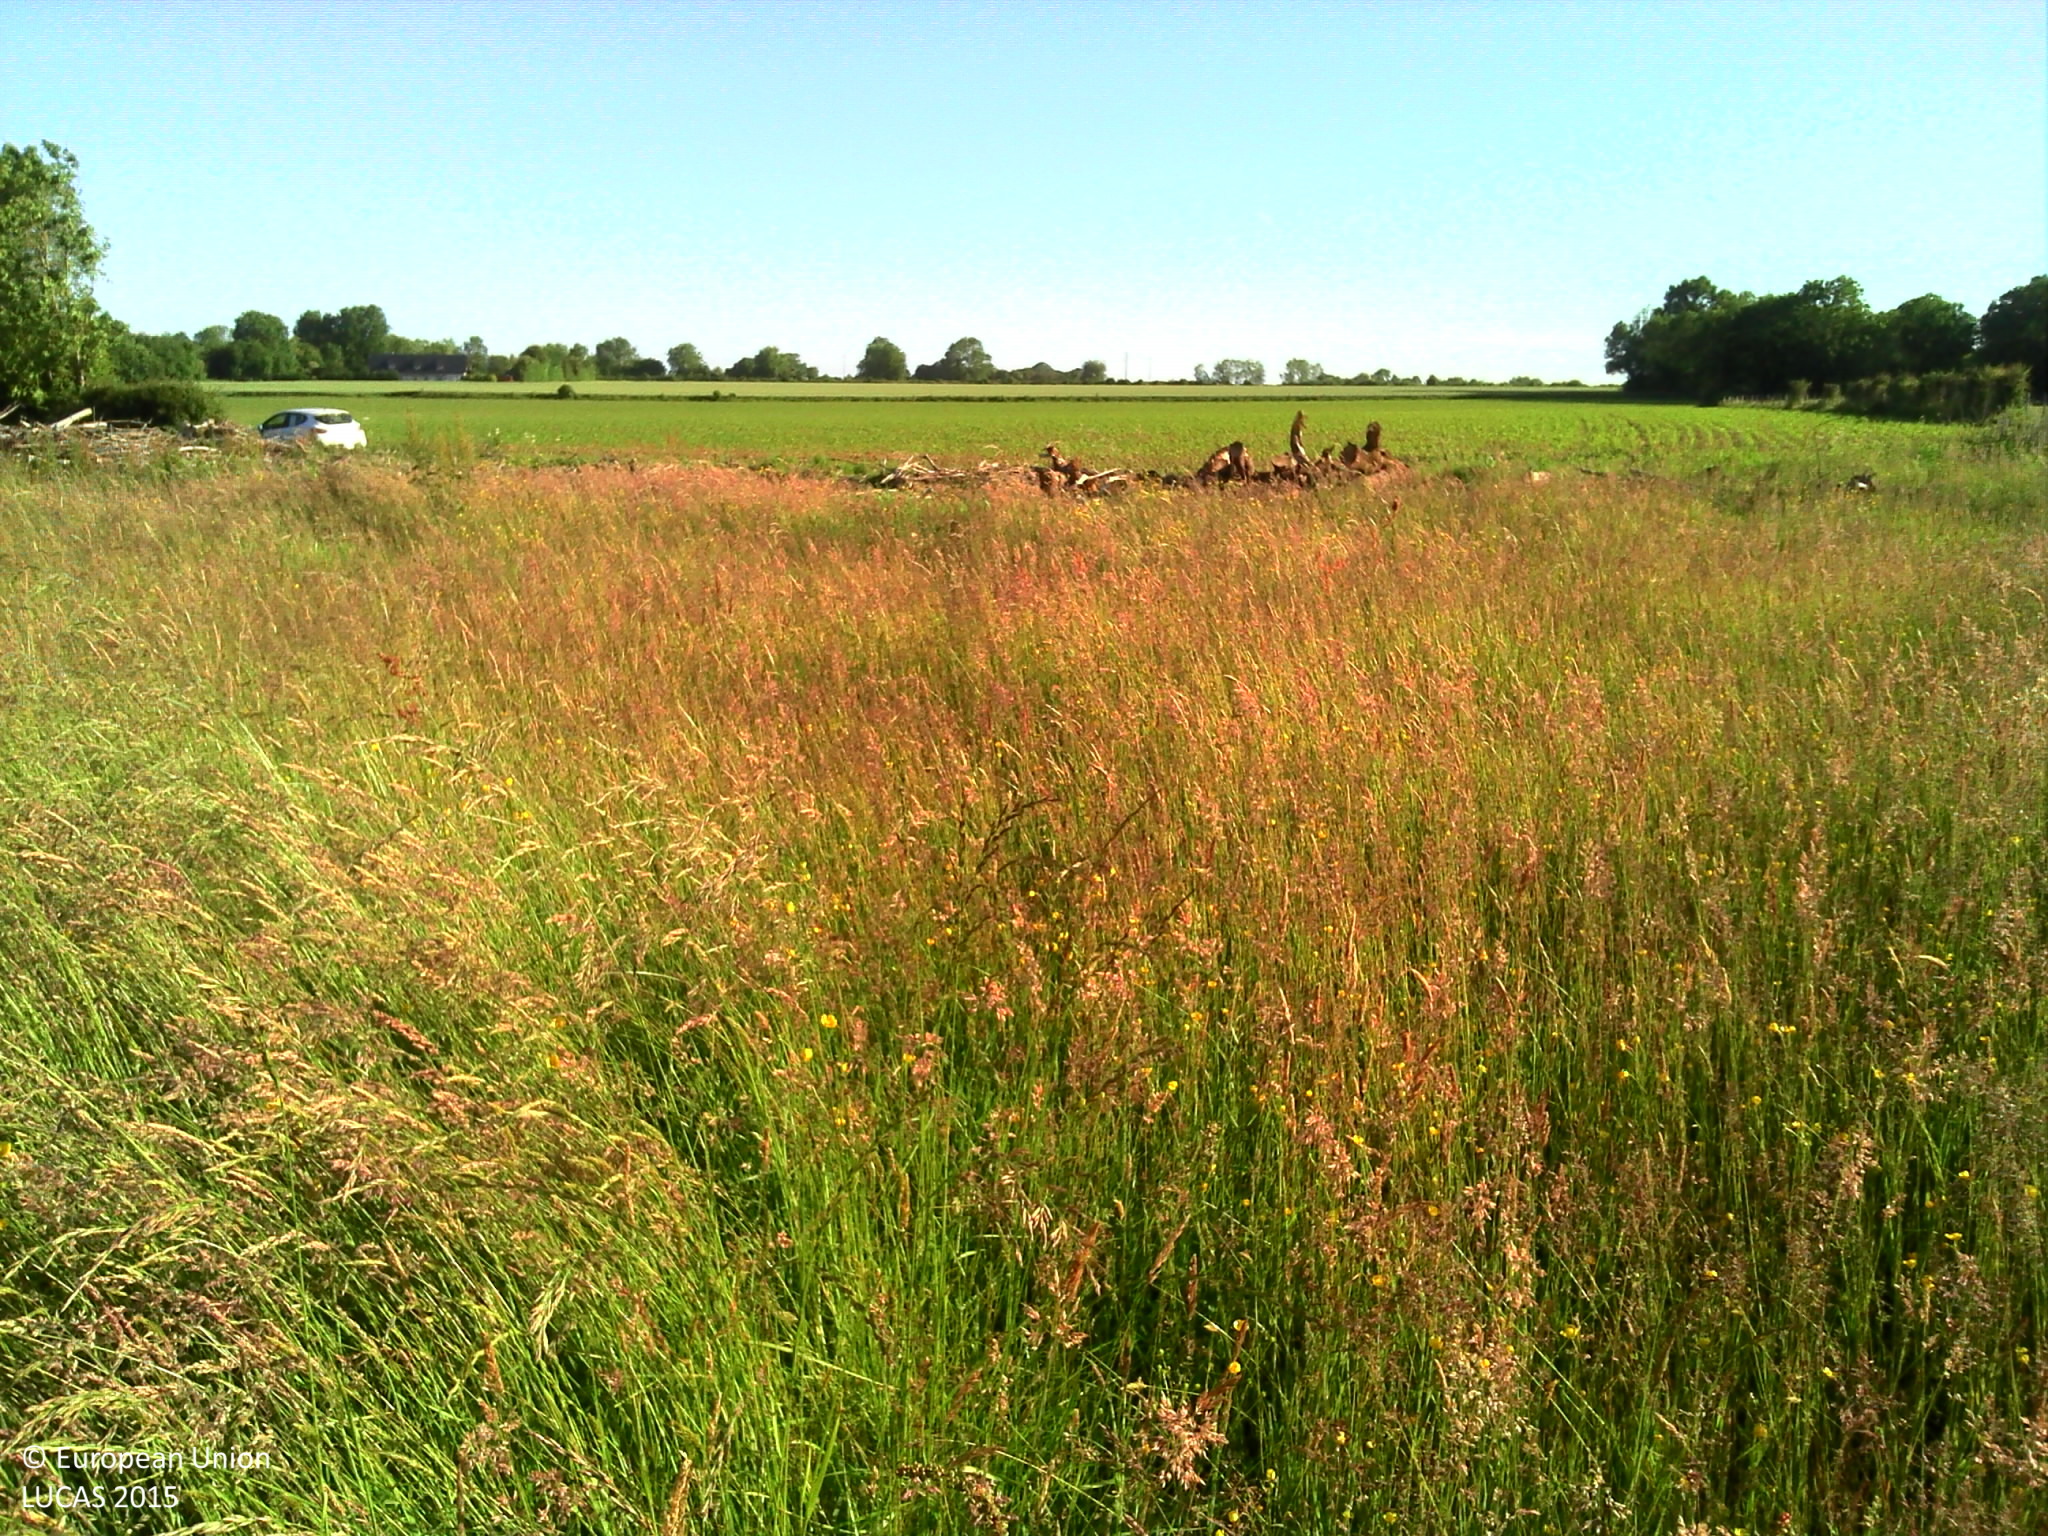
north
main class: Grassland
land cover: Grassland without tree/shrub cover
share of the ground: > 75 %
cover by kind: herbaceous plants 100 %
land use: Agriculture (excluding fallow land and kitchen gardens)
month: June
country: FR
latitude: 49.1768
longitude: 0.3564
